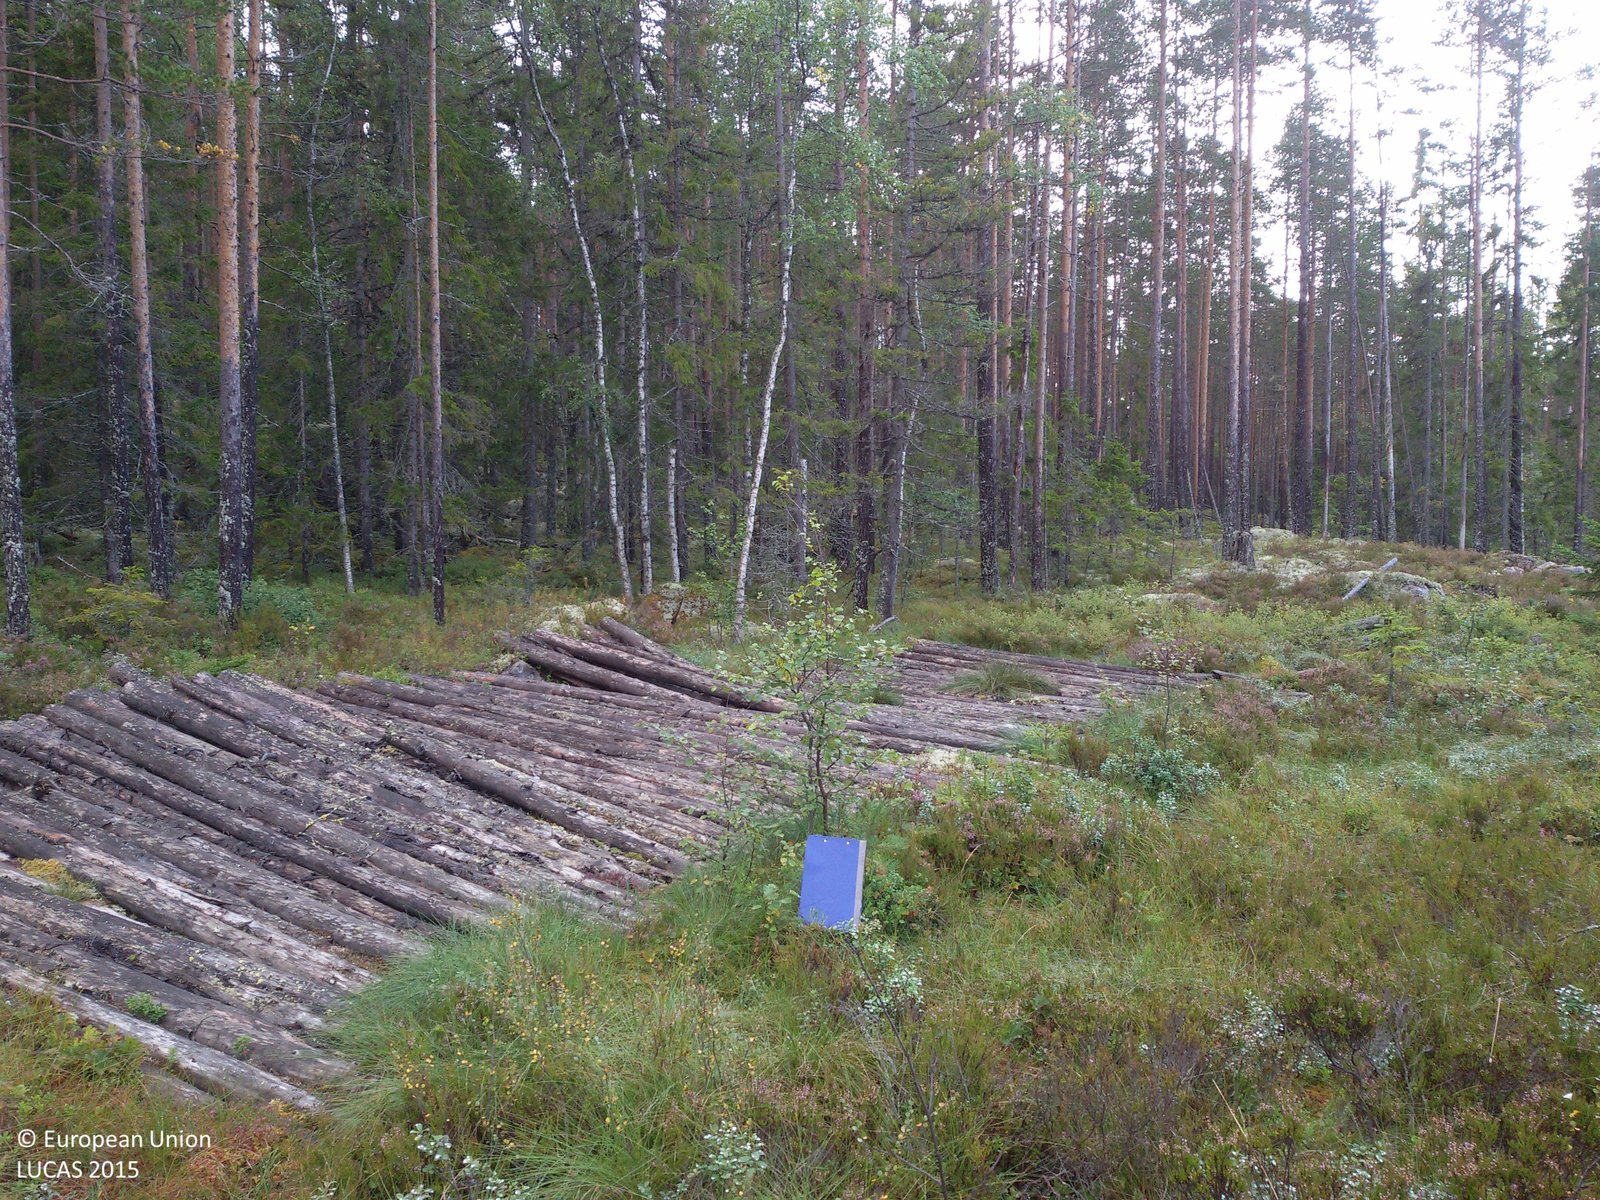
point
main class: Woodland
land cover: Pine dominated mixed woodland
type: boreal forest
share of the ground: 50 - 75 %
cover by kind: herbaceous plants 40 %, coniferous forest trees 30 %, broadleaved forest trees 30 %
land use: Forestry
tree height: > 5 m
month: September
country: SE
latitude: 61.0724
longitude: 15.3417
